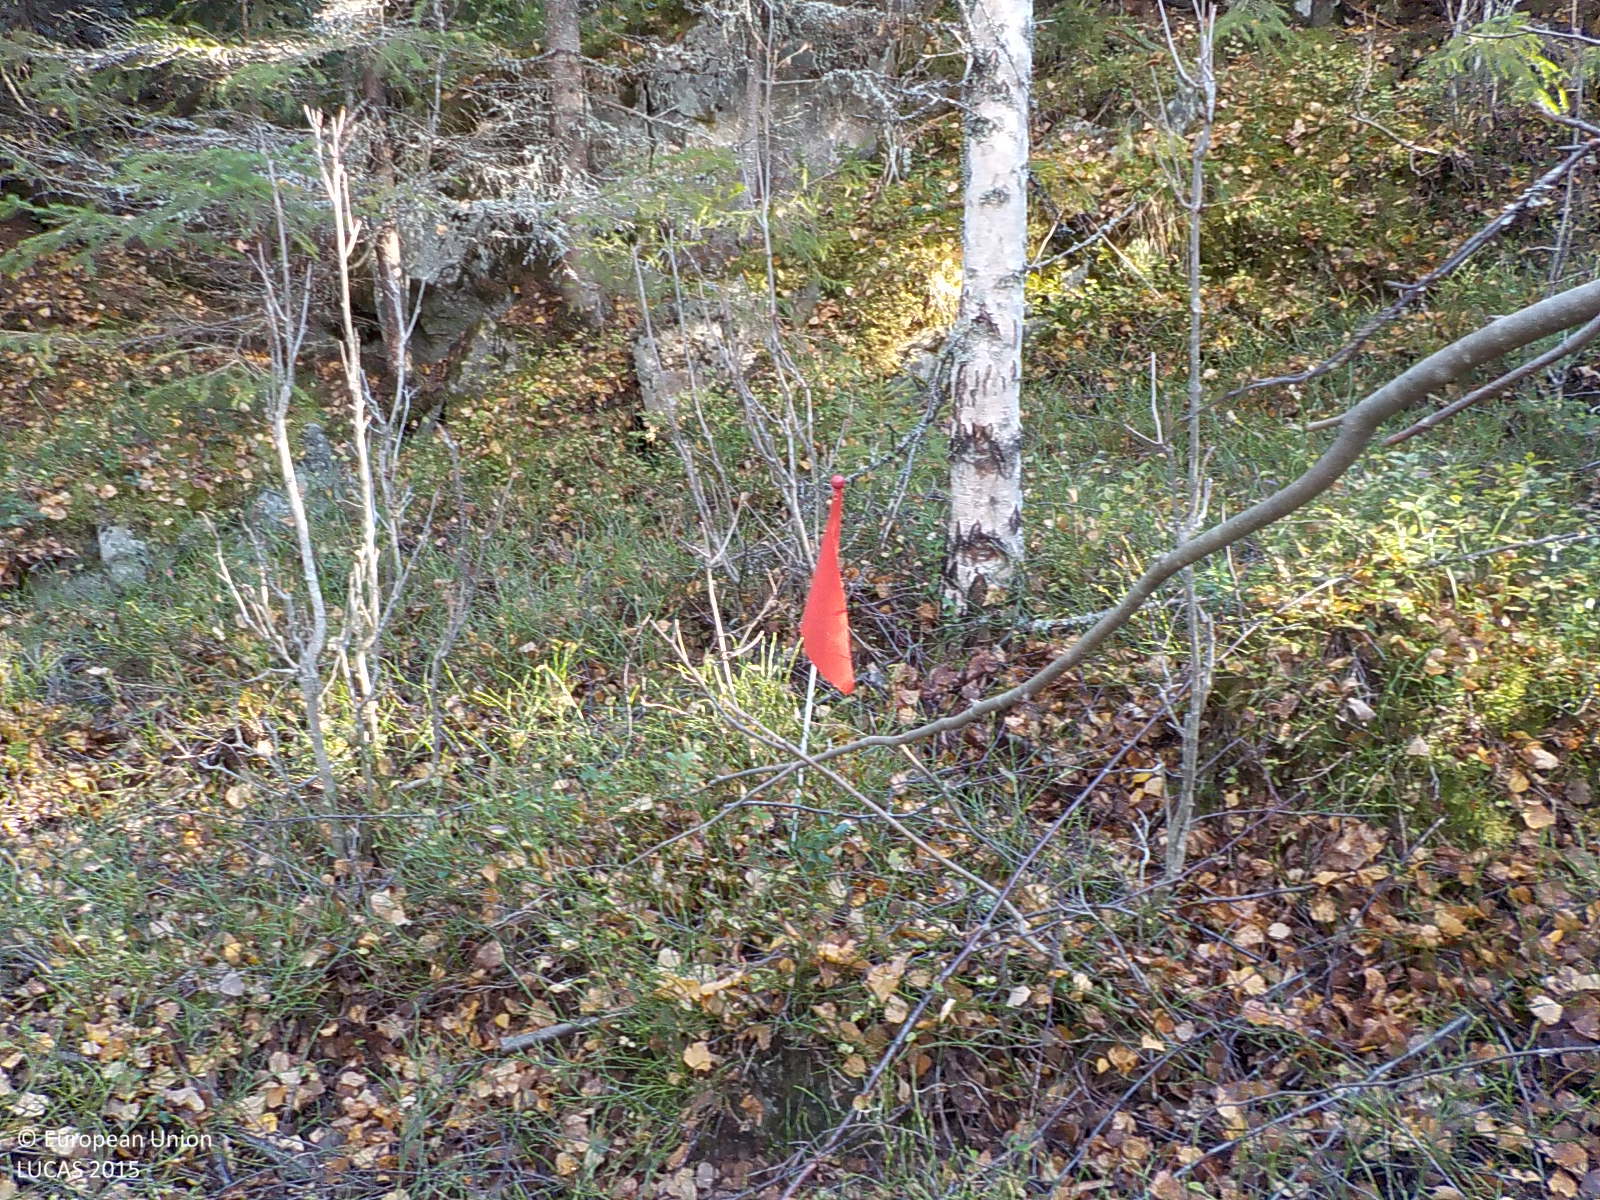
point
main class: Woodland
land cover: Broadleaved woodland
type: hemiboreal forest and nemoral coniferous forest and mixed broadleaved-coniferous forest
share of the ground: 50 - 75 %
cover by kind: broadleaved forest trees 60 %, shrubs 20 %, coniferous forest trees 10 %, lichens and mosses 10 %
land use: Forestry
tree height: > 5 m
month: October
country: SE
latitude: 62.9828
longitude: 18.2862
